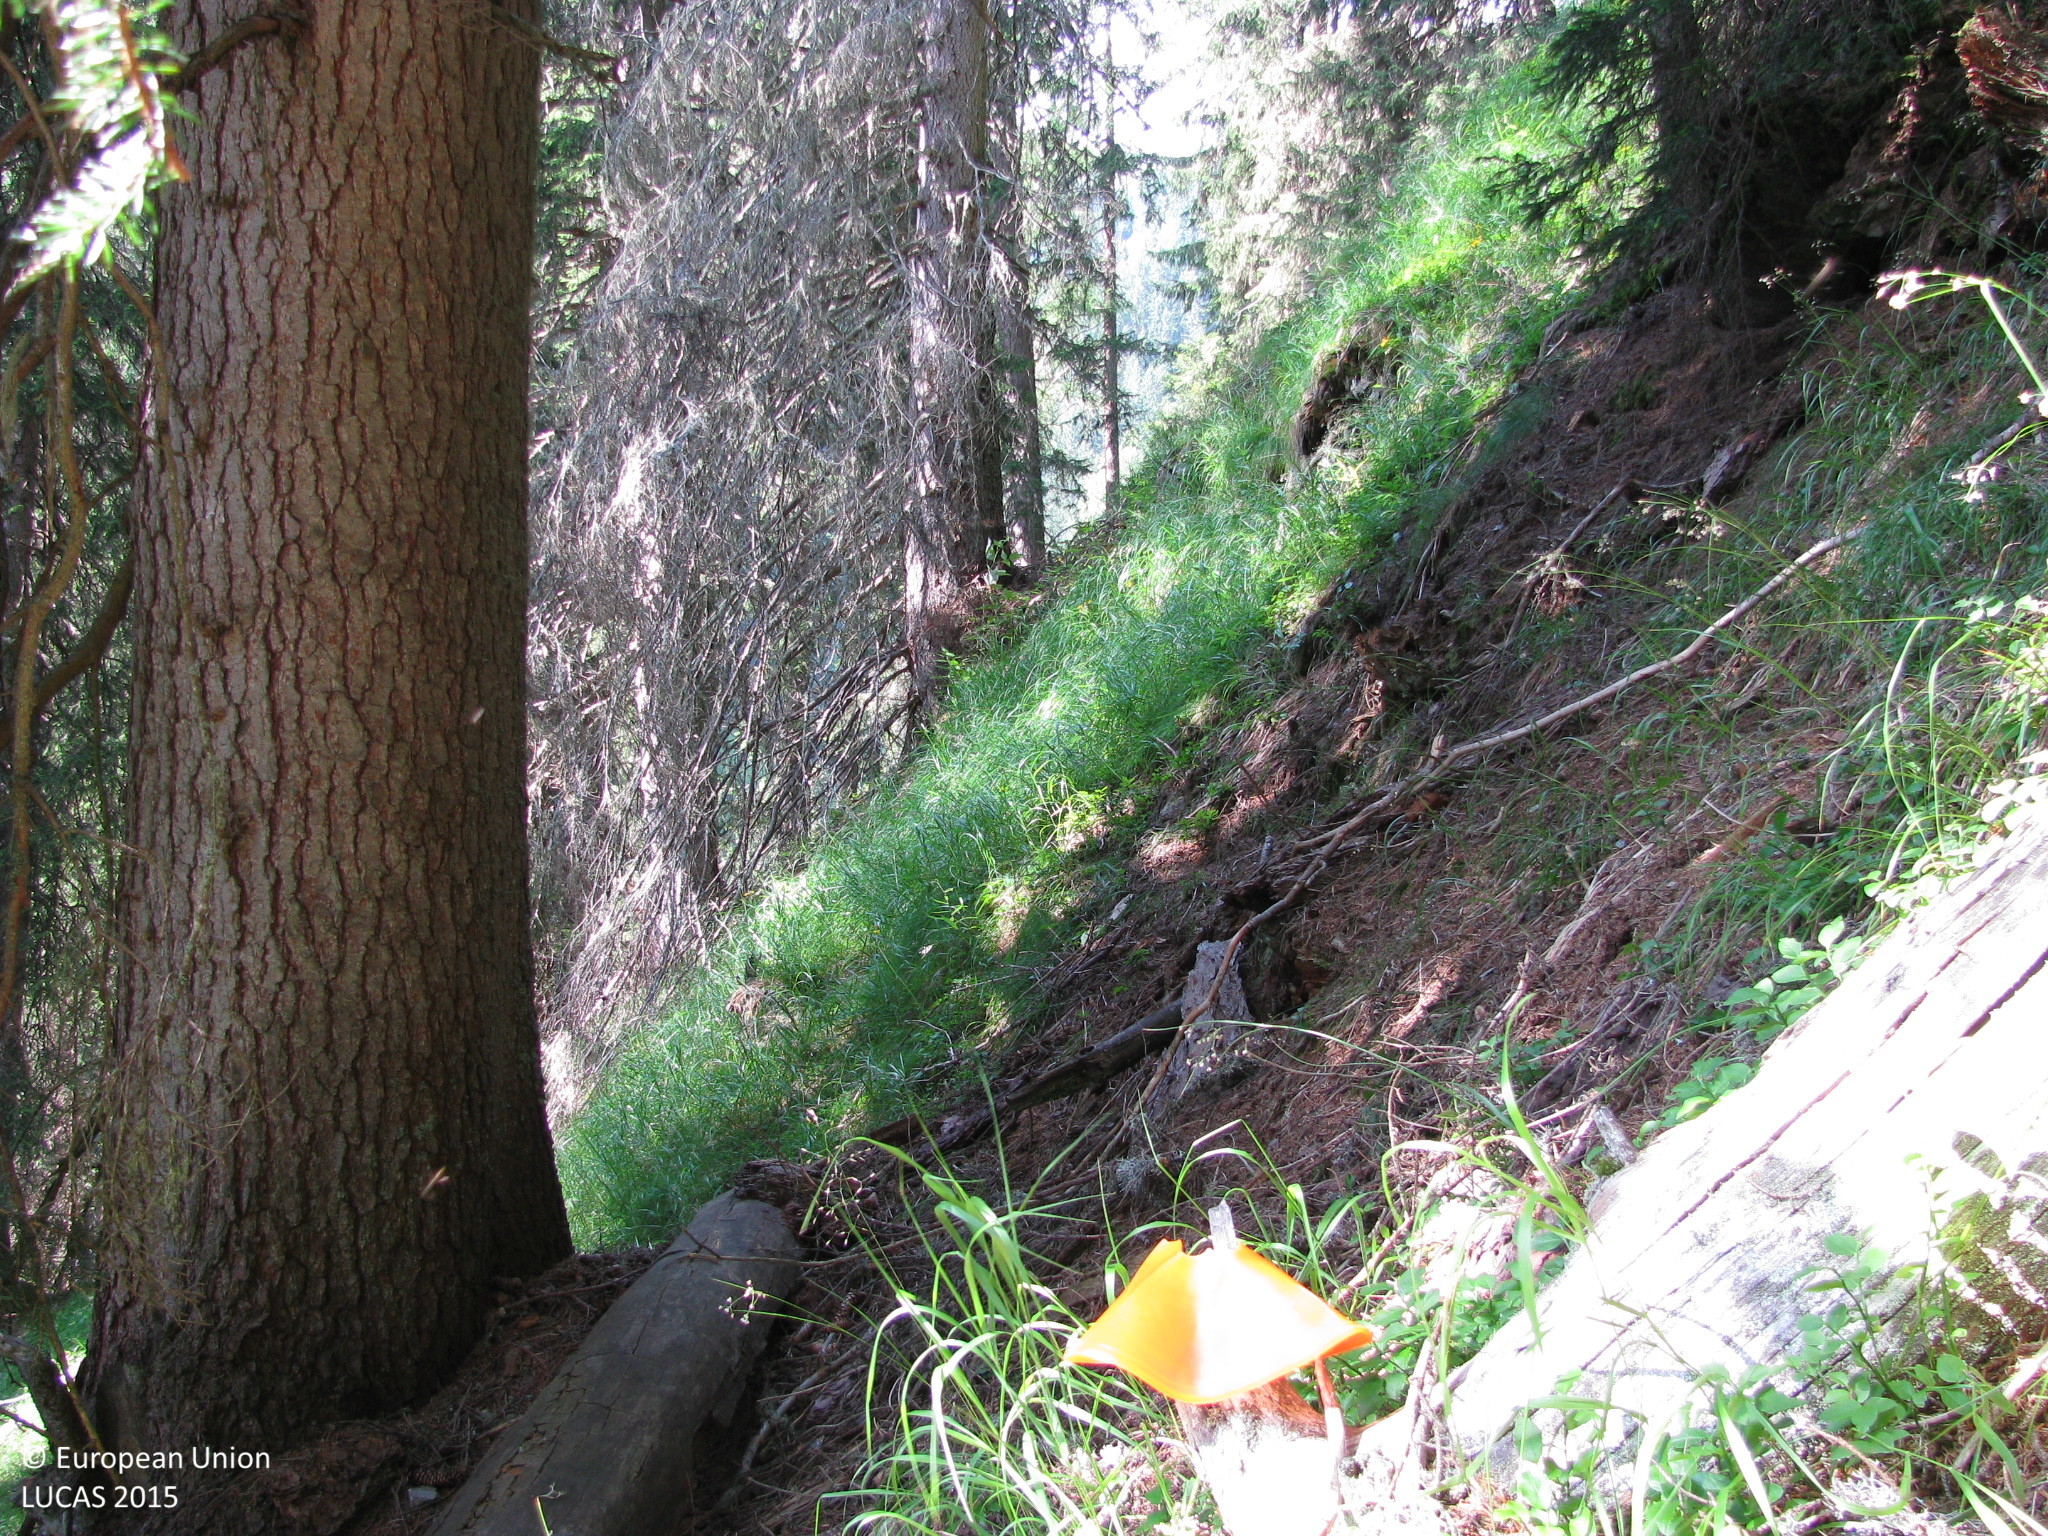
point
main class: Woodland
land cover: Spruce dominated coniferous woodland
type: alpine coniferous forest
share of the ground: > 75 %
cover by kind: coniferous forest trees 85 %, herbaceous plants 10 %, unconsolidated bare surface 5 %
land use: Forestry
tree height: > 5 m
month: July
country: AT
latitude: 46.7160
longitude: 12.6008
